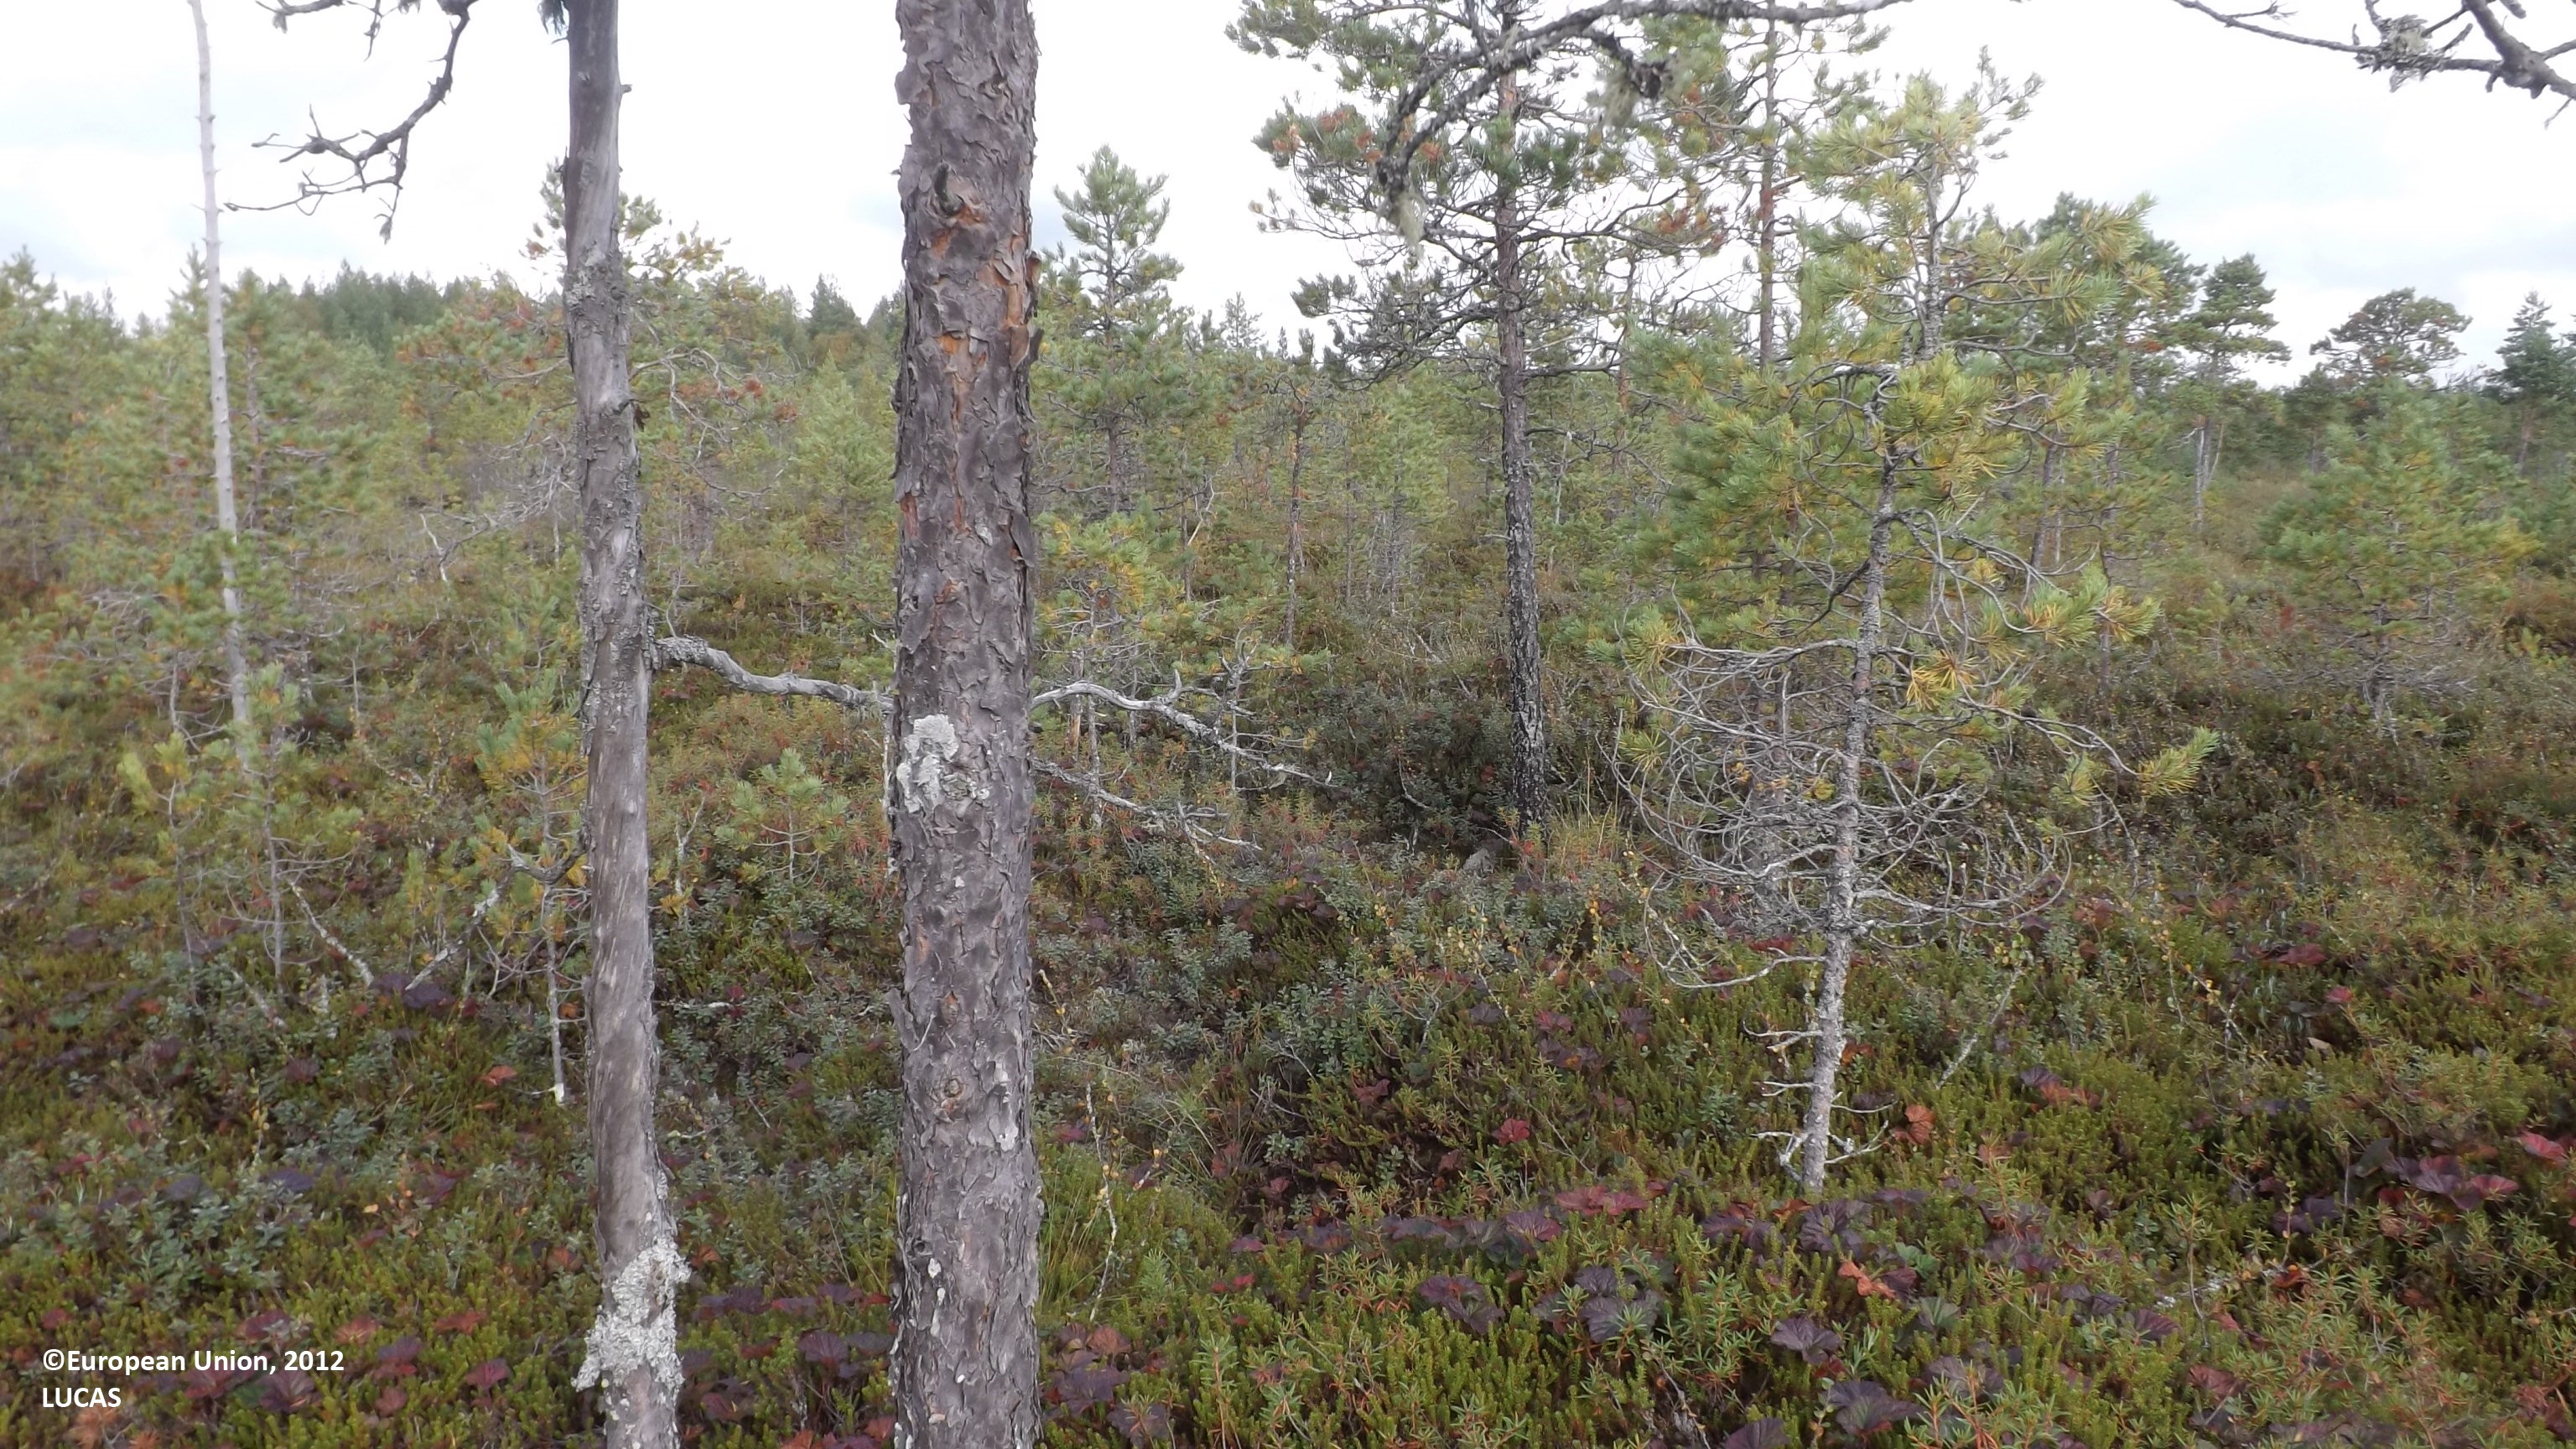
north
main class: Woodland
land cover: Pine dominated coniferous woodland
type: mire and swamp forests
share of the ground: 10 - 25 %
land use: Forestry
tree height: < 5 m
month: August
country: FI
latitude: 63.8617
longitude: 23.6309
